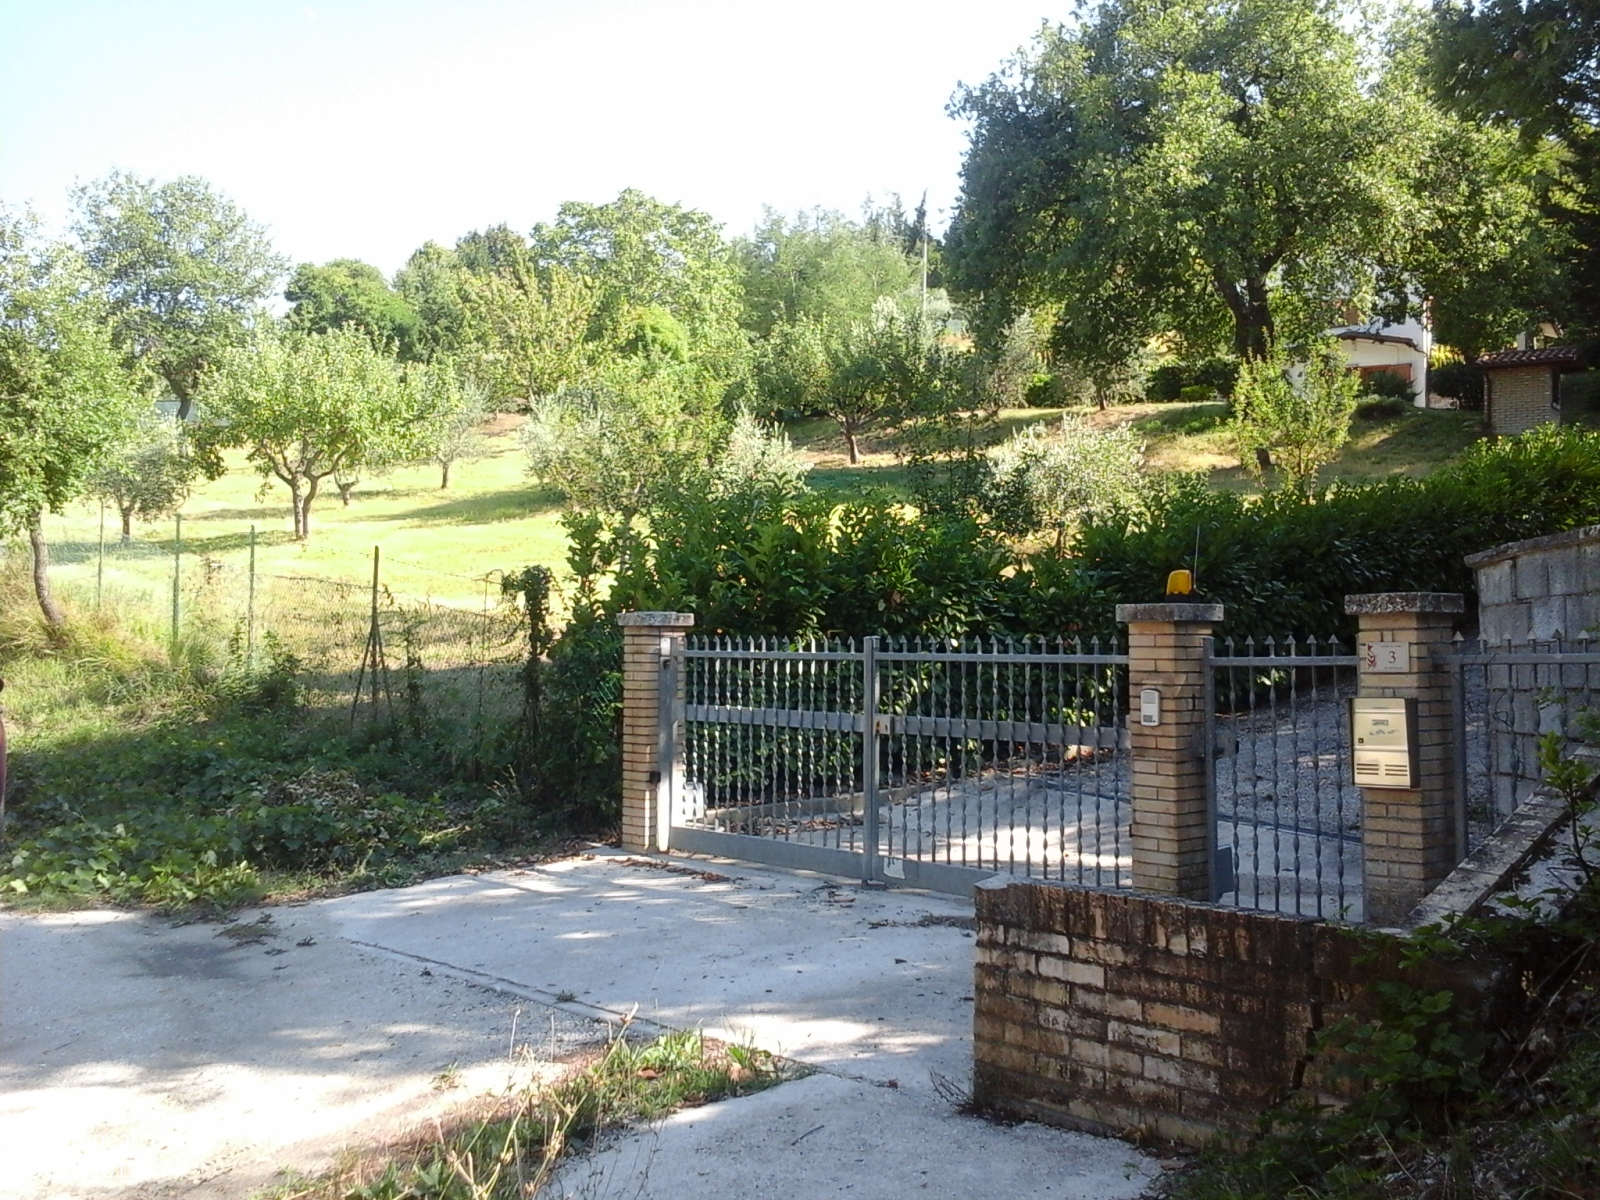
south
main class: Shrubland
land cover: Shrubland with sparse tree cover
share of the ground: > 75 %
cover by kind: shrubs 95 %, broadleaved forest trees 5 %
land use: Semi-natural and natural areas not in use
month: August
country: IT
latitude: 43.7388
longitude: 12.6630
